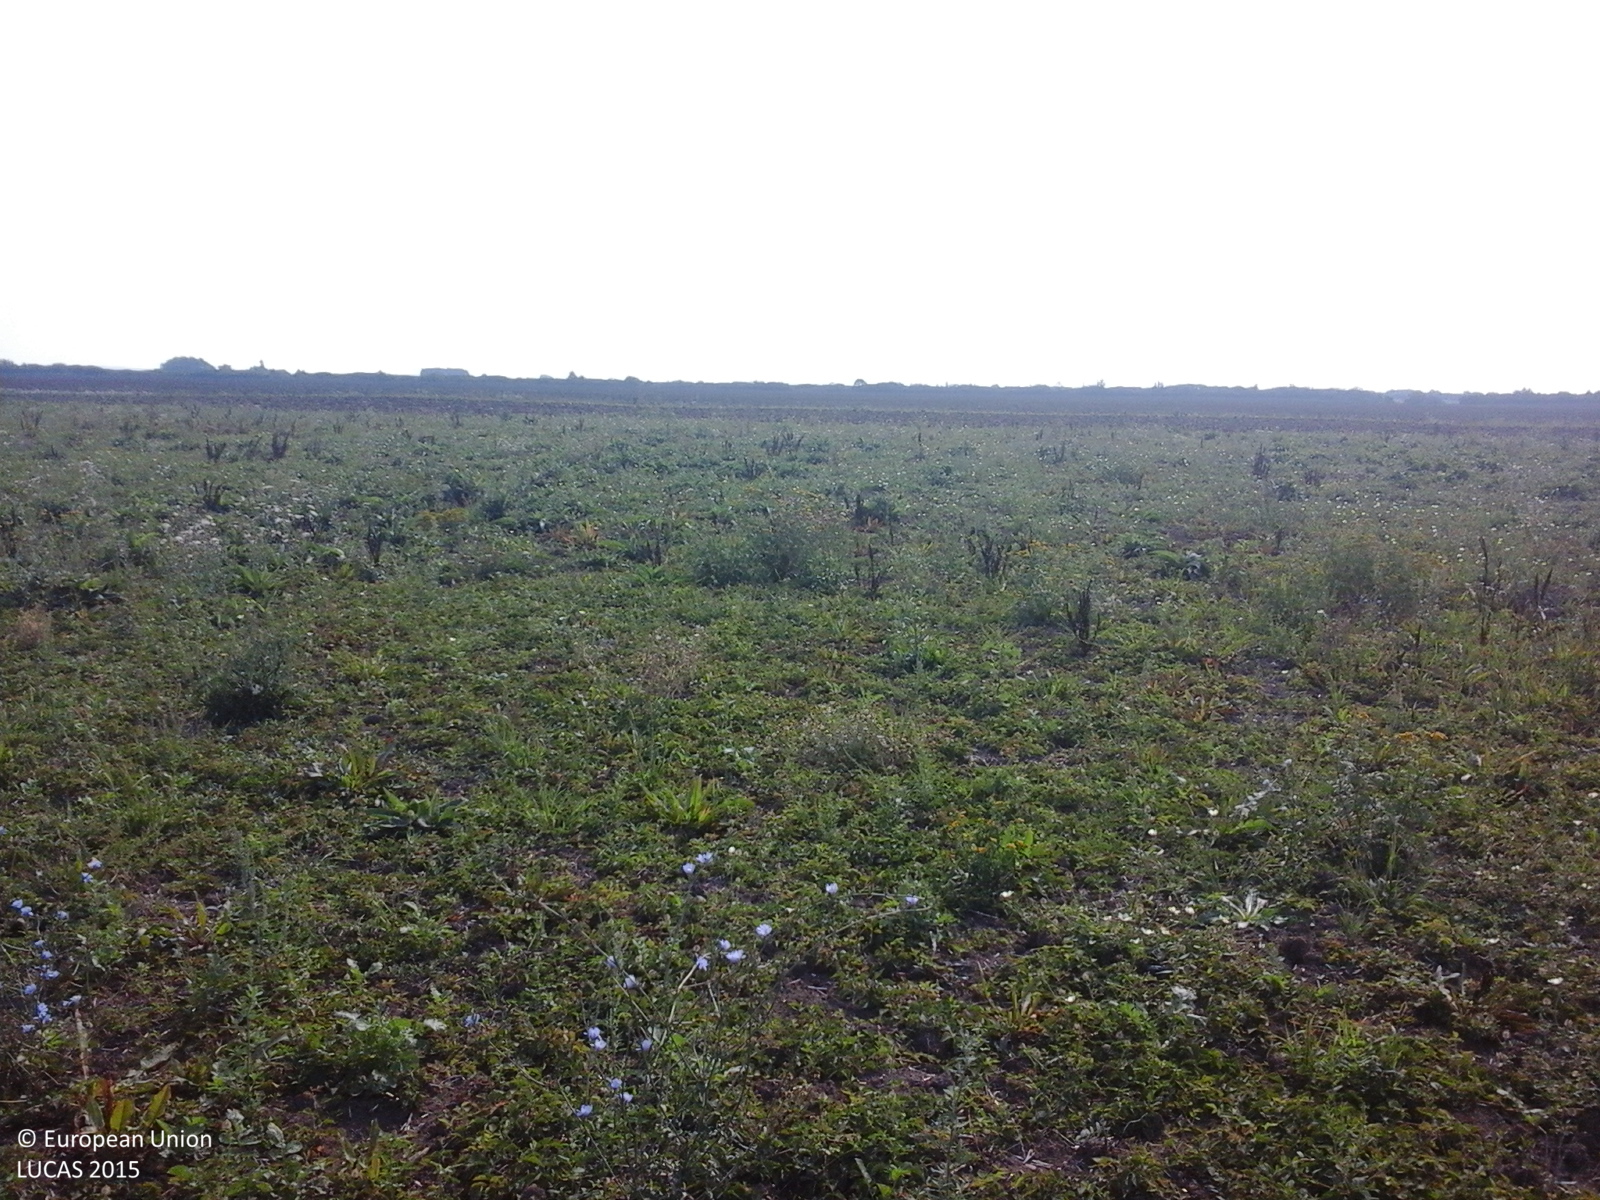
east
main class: Grassland
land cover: Spontaneously vegetated surfaces
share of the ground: > 75 %
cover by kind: herbaceous plants 100 %
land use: Agriculture (excluding fallow land and kitchen gardens)
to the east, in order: Spontaneously vegetated surfaces; Other bare soil
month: August
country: RO
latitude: 46.5450
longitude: 21.6860
